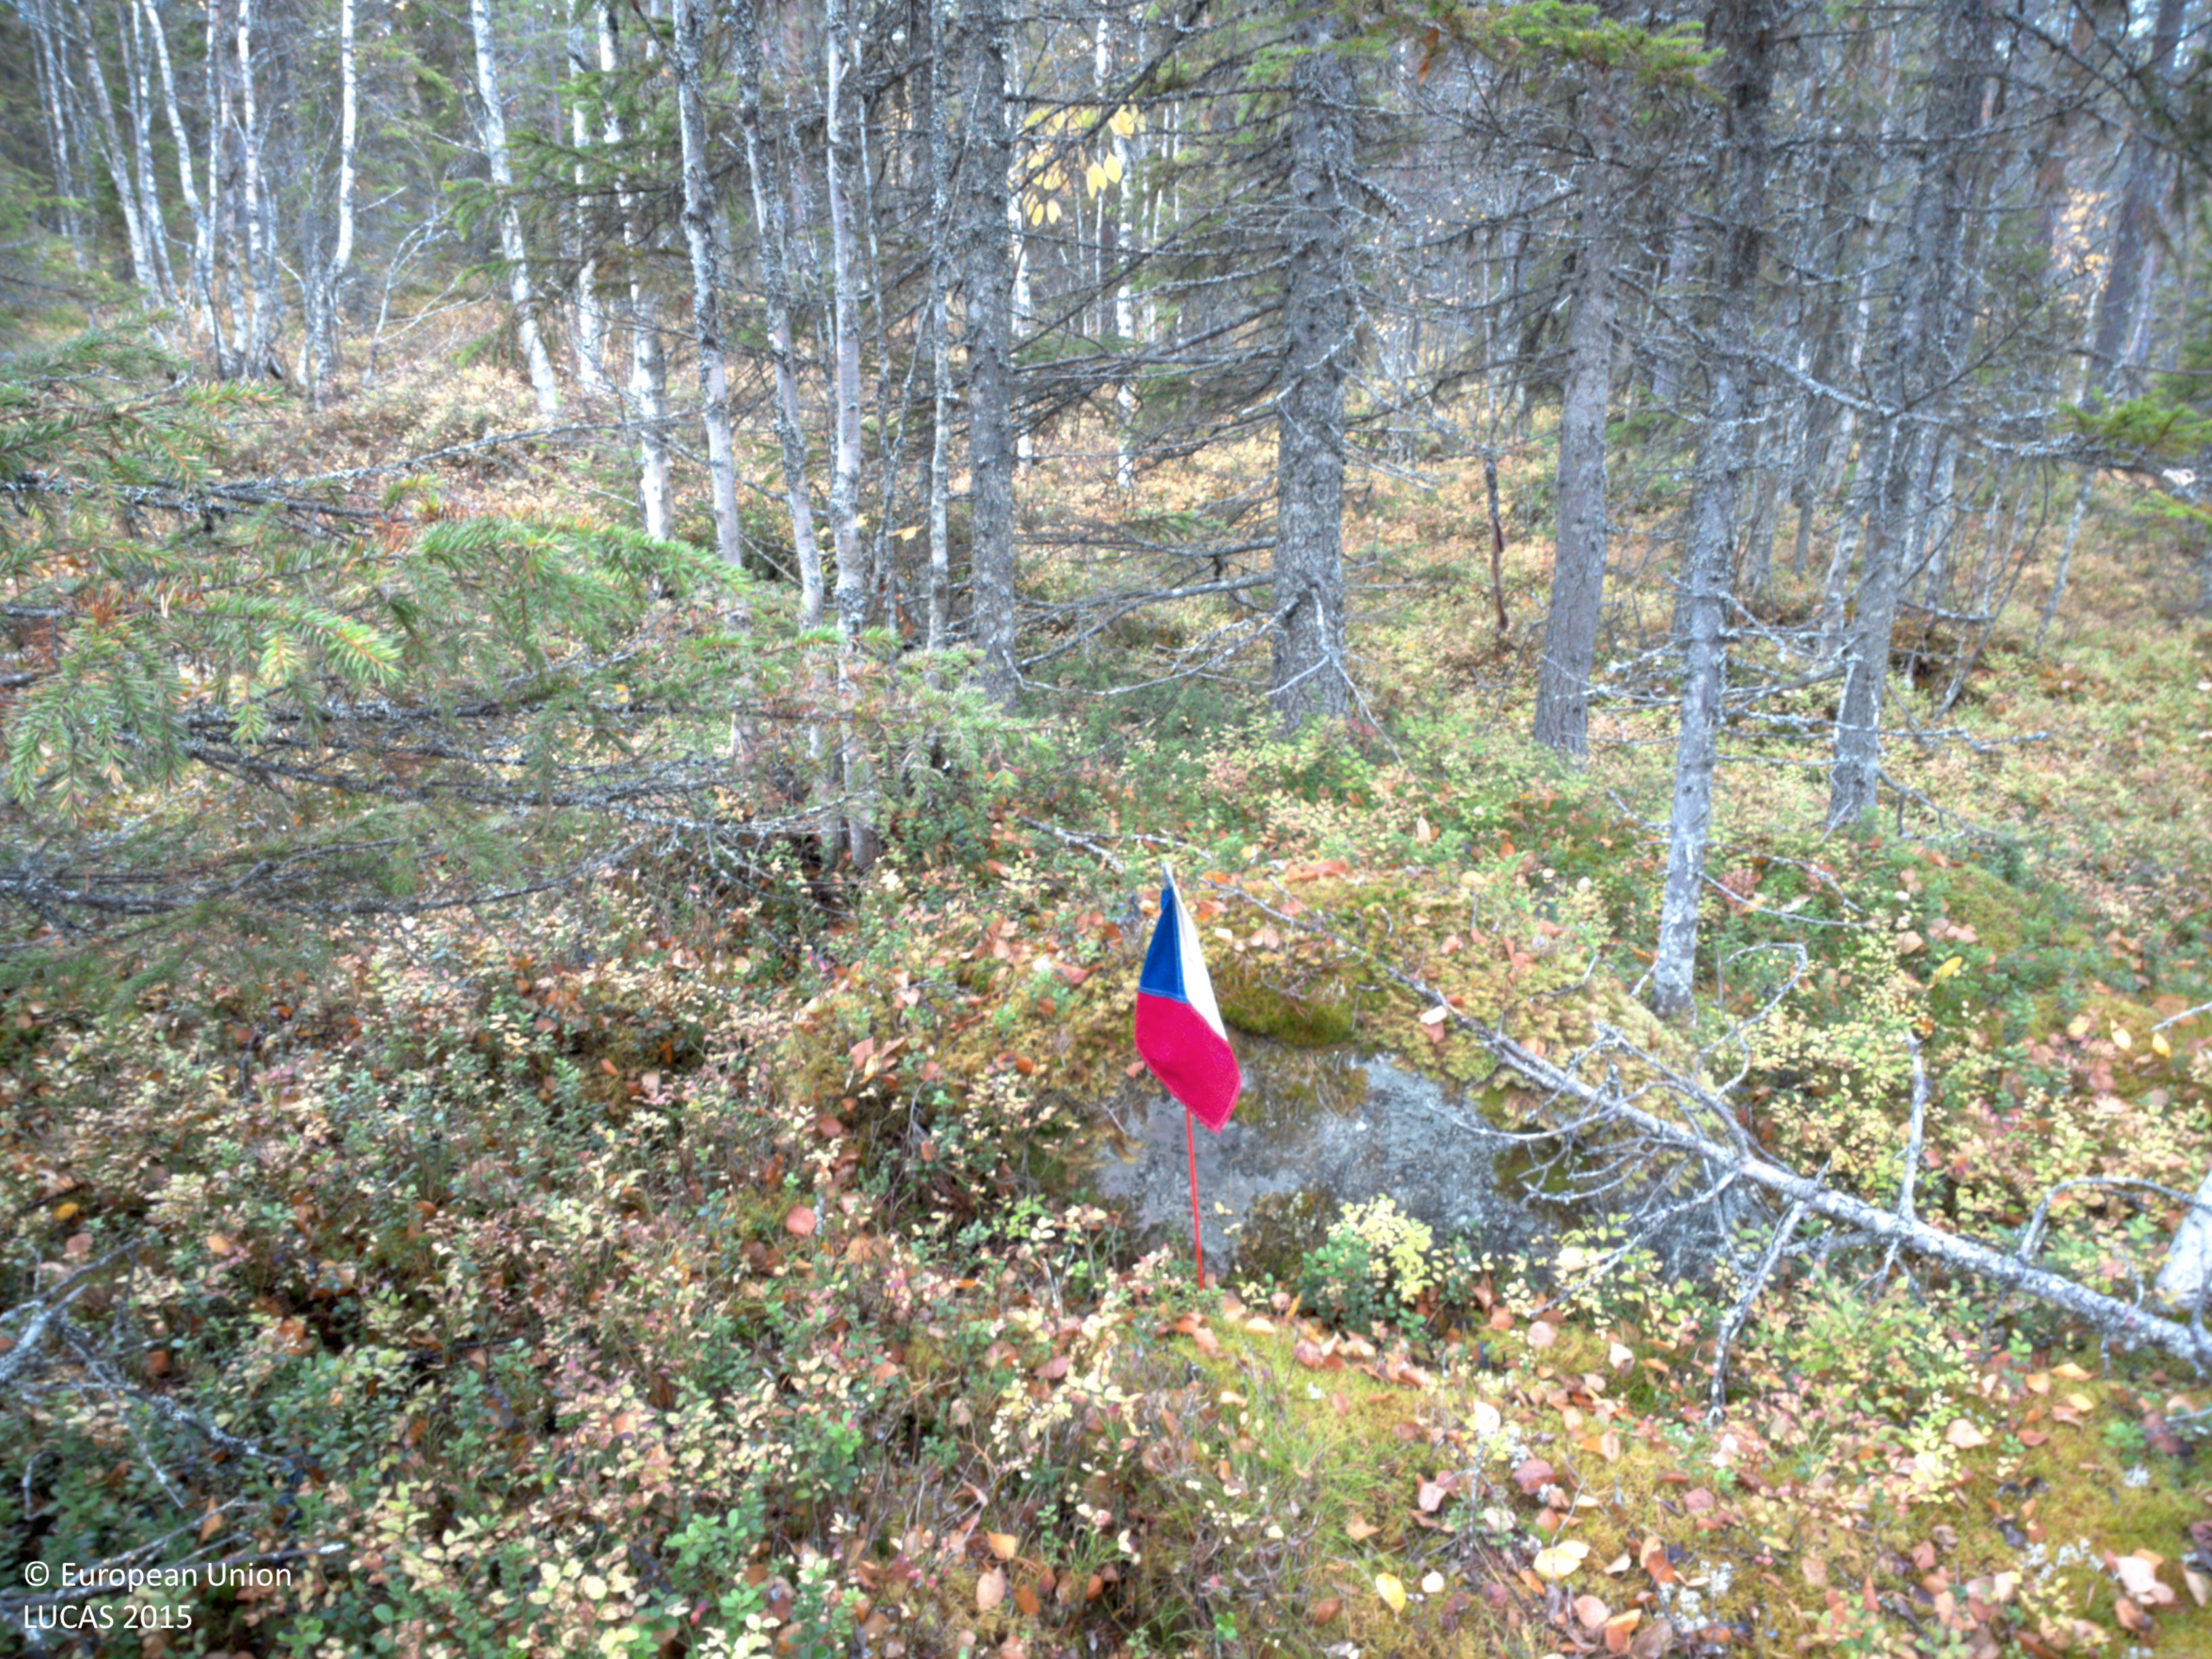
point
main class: Woodland
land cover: Other coniferous woodland
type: boreal forest
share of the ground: 50 - 75 %
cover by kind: coniferous forest trees 65 %, shrubs 20 %, broadleaved forest trees 5 %, herbaceous plants 5 %, lichens and mosses 5 %
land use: Forestry
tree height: > 5 m
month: October
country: SE
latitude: 64.9819
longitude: 17.9109
